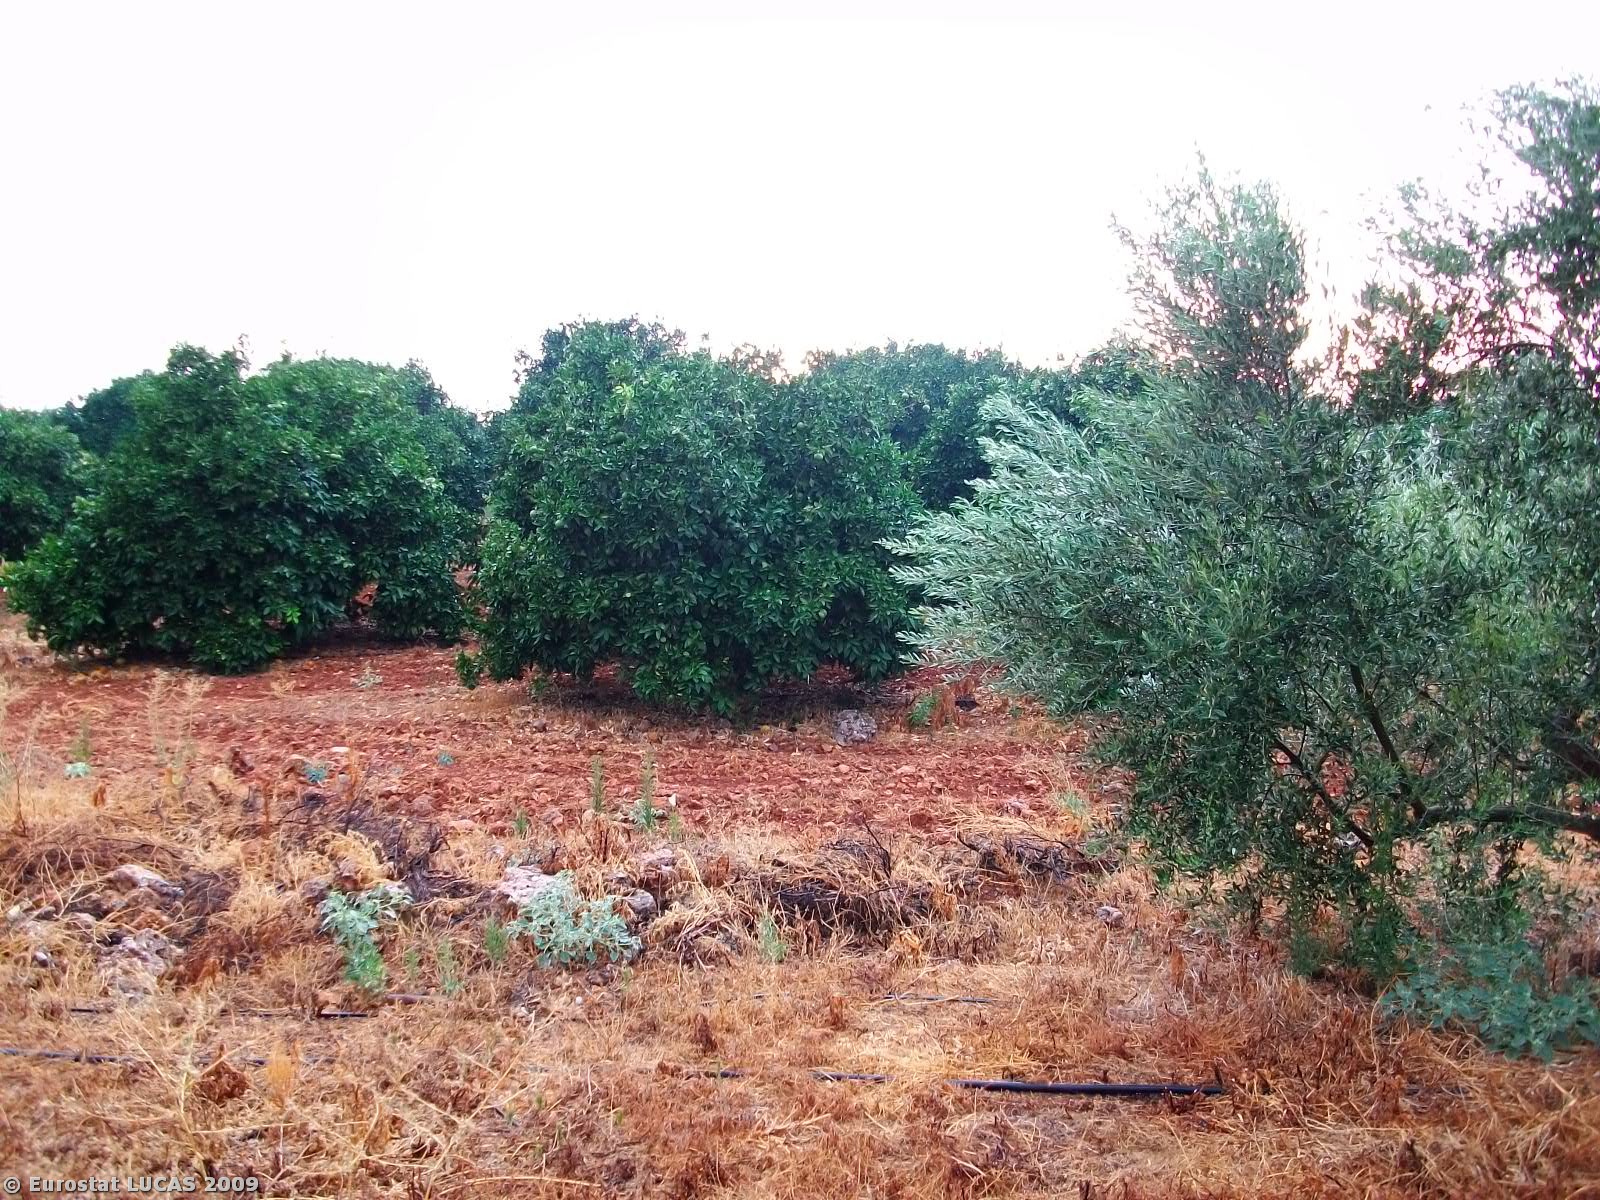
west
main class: Cropland
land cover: Pear fruit
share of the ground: 10 - 25 %
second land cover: Grassland with sparse tree/shrub cover
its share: > 75 %
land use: Agriculture (excluding fallow land and kitchen gardens)
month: August
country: GR
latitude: 36.9054
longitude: 22.7386
